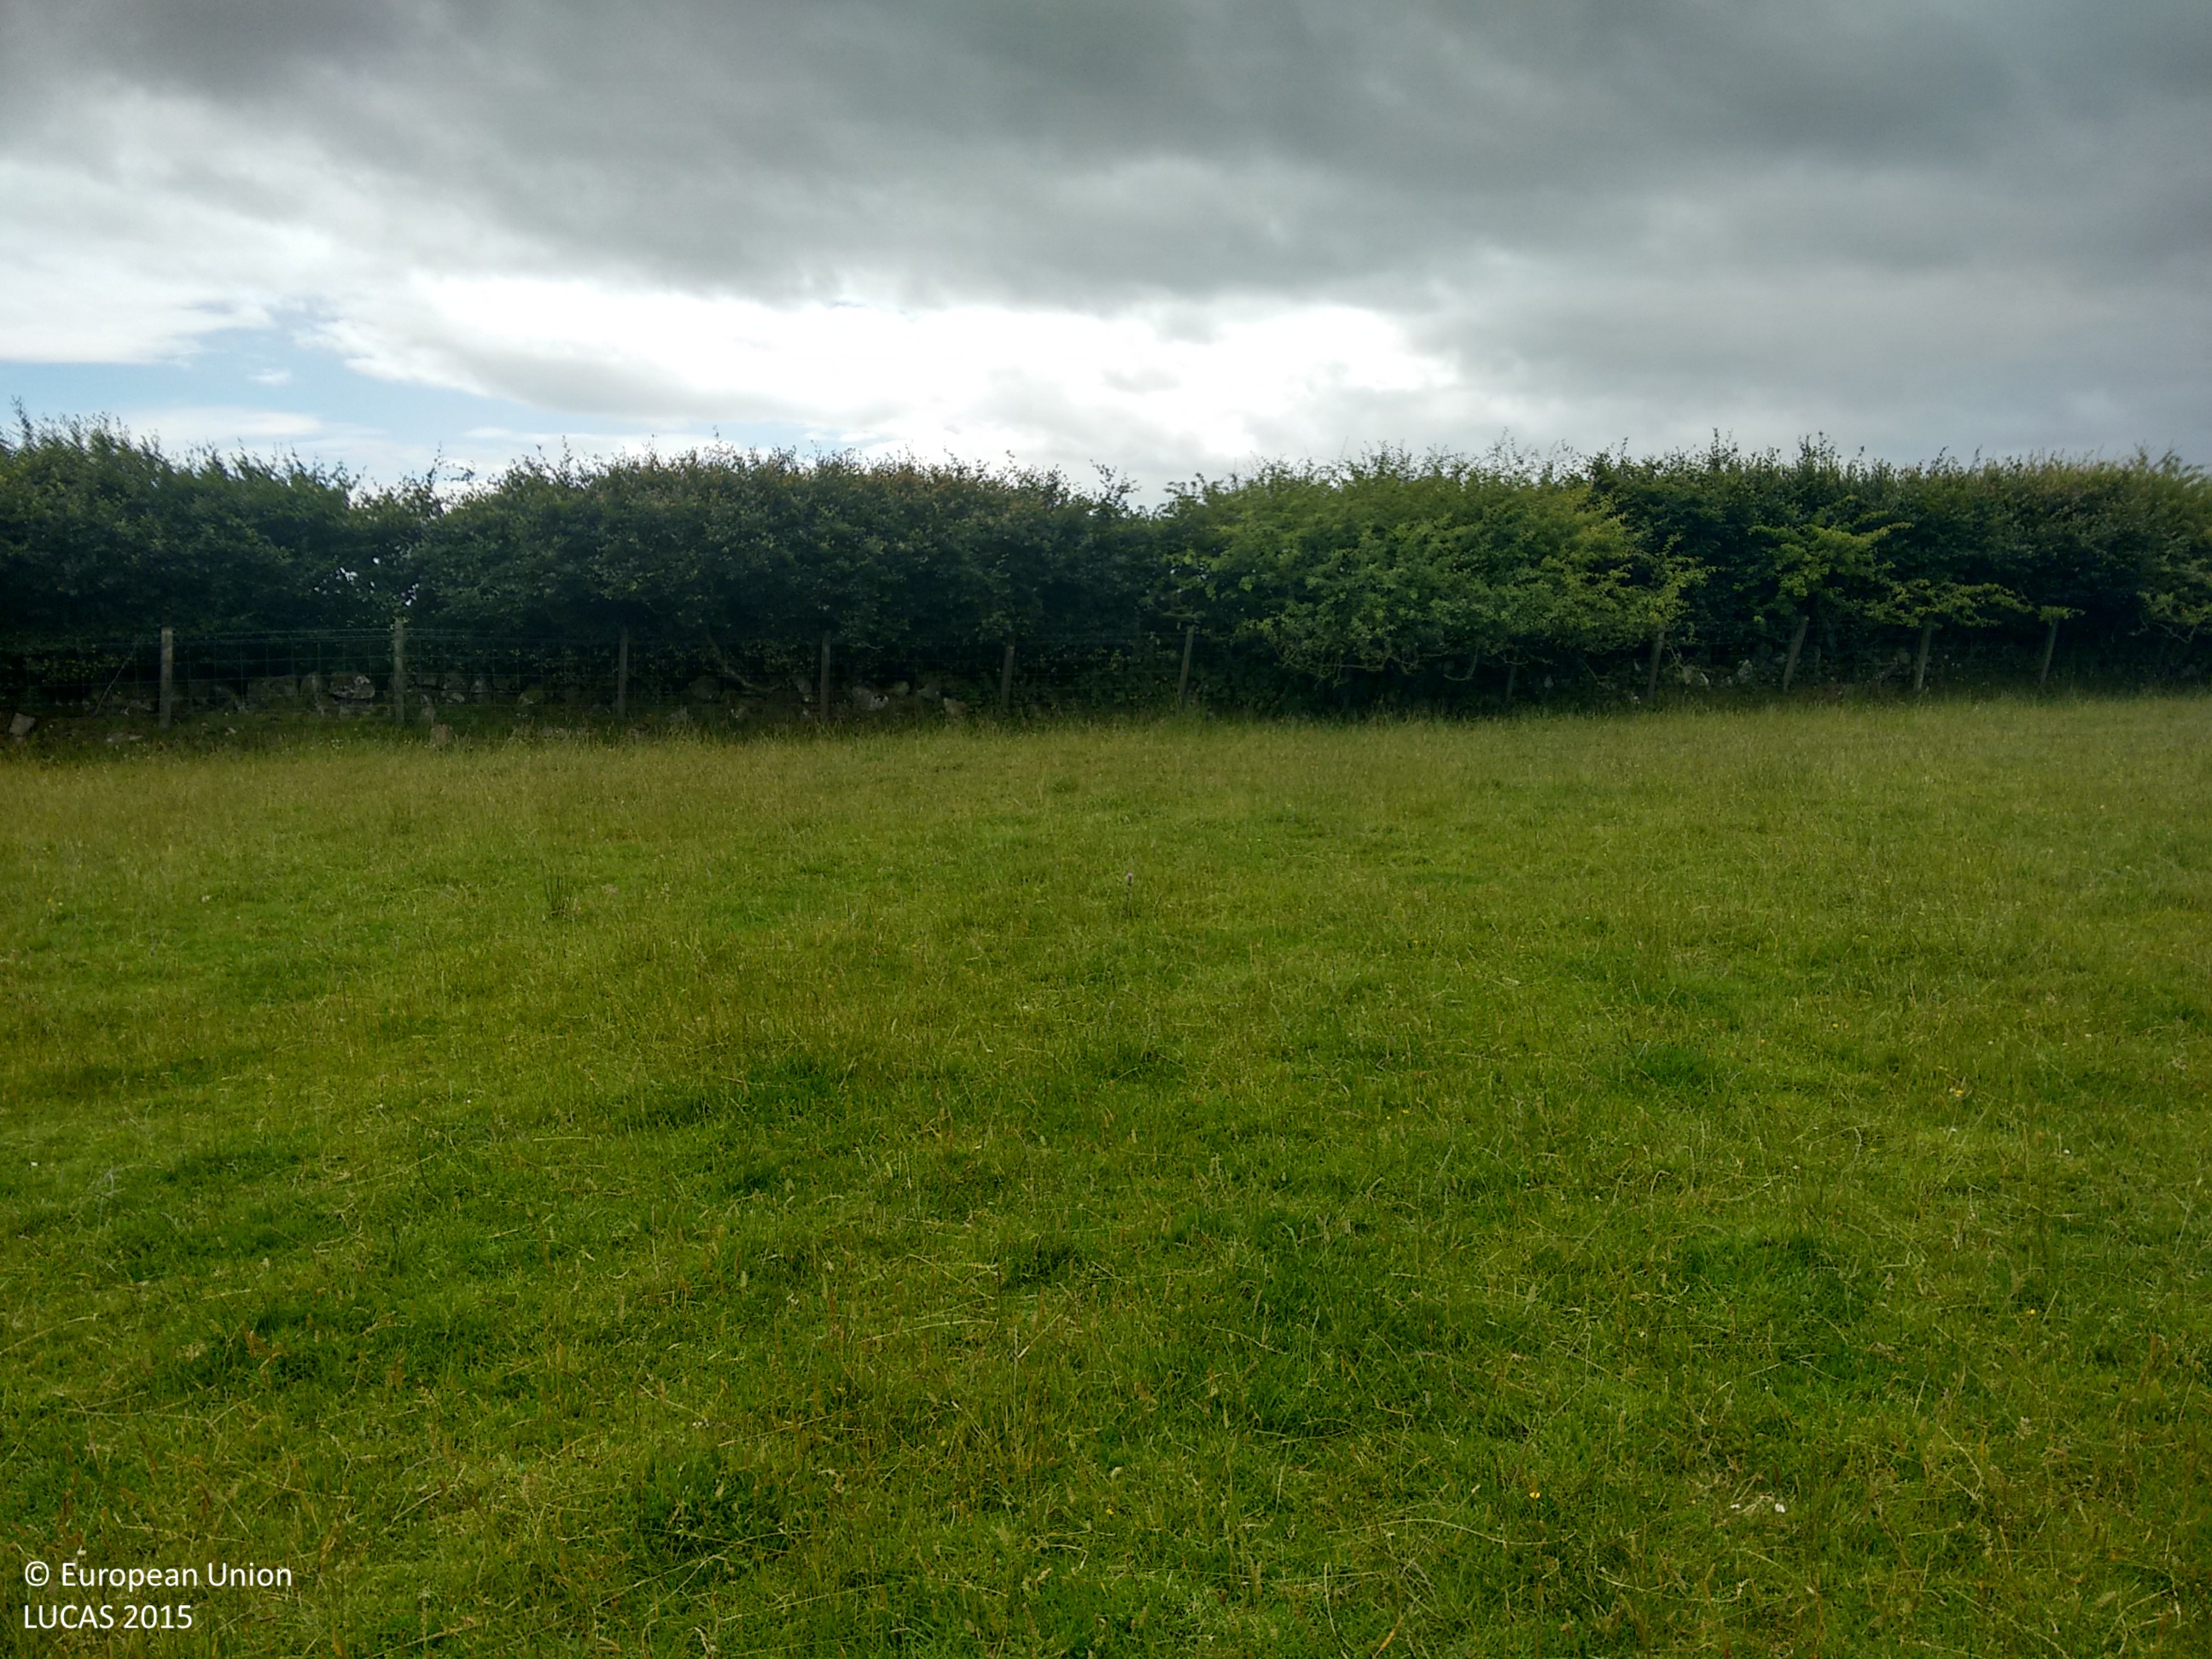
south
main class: Grassland
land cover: Grassland without tree/shrub cover
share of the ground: > 75 %
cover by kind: herbaceous plants 100 %
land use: Agriculture (excluding fallow land and kitchen gardens)
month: August
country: GB
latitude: 56.2625
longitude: -2.8999
